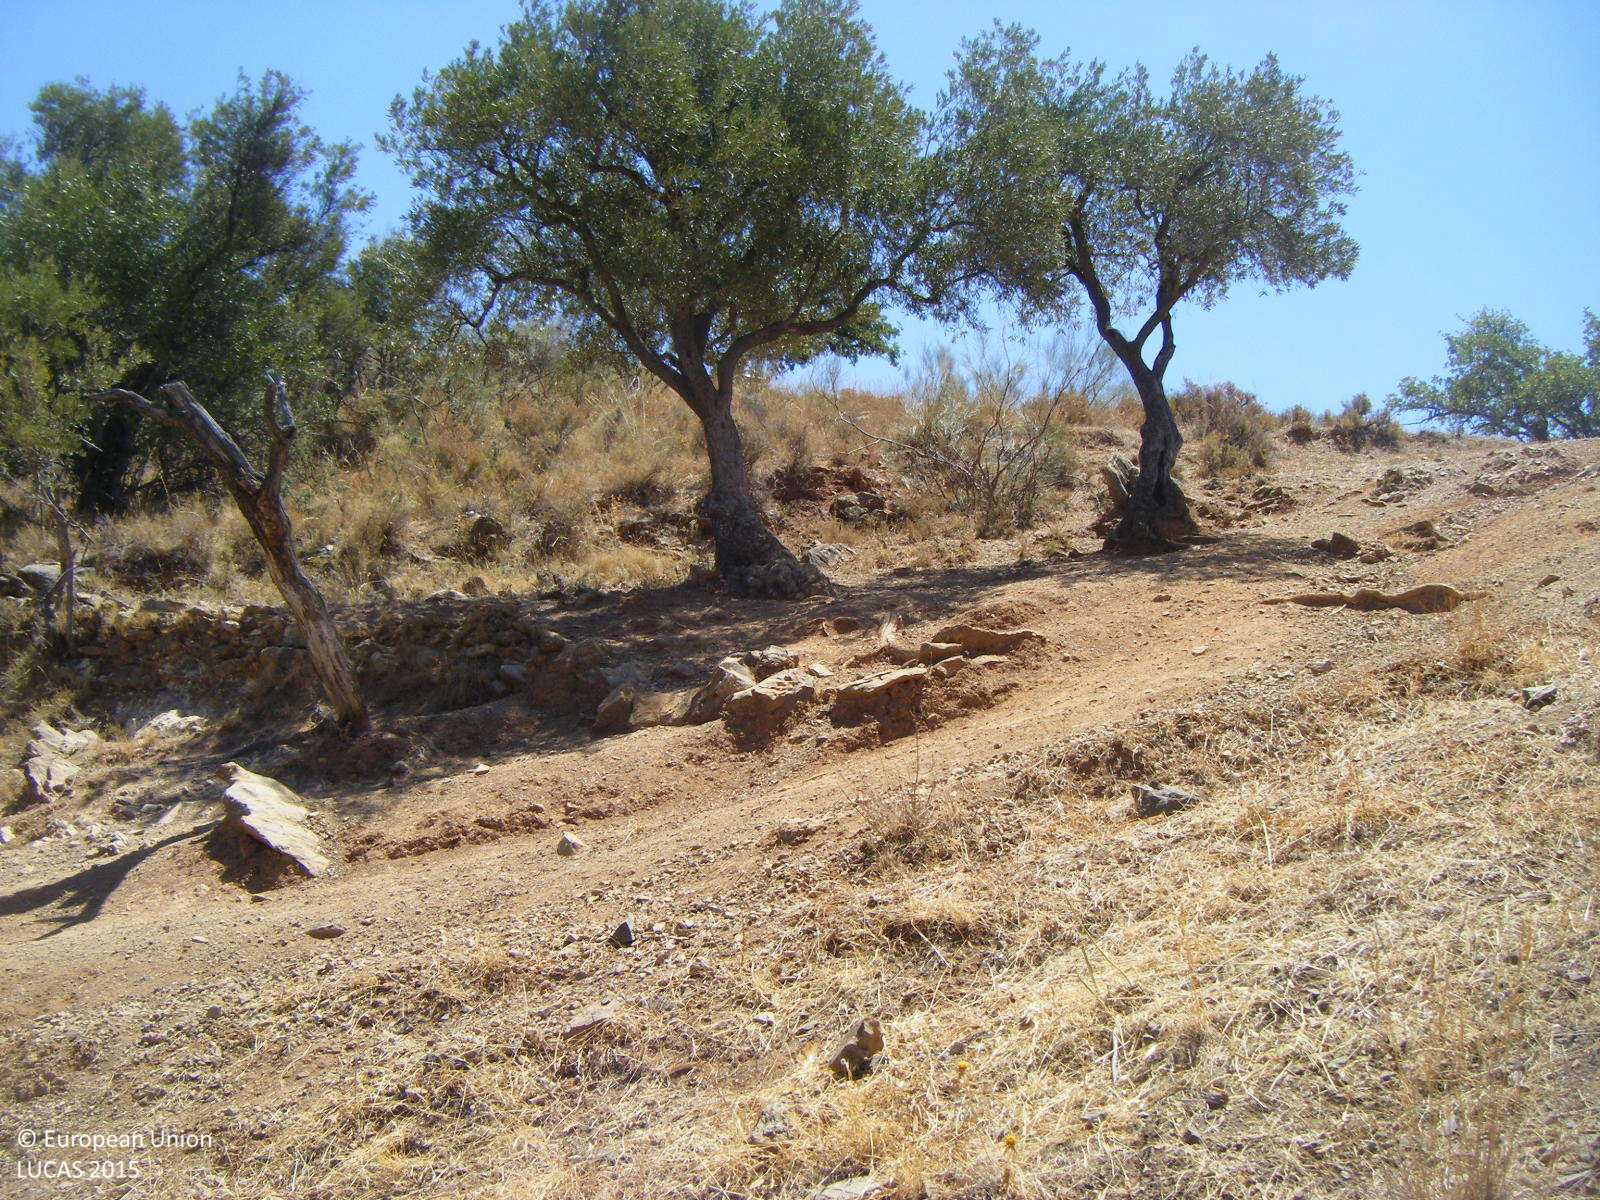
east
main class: Cropland
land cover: Olive groves
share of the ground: 10 - 25 %
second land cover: Spontaneously vegetated surfaces
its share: > 75 %
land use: Agriculture (excluding fallow land and kitchen gardens)
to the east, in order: Olive groves; Spontaneously vegetated surfaces; Shrubland with sparse tree cover; Tracks; Shrubland with sparse tree cover
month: July
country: ES
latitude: 36.7471
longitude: -4.3366
